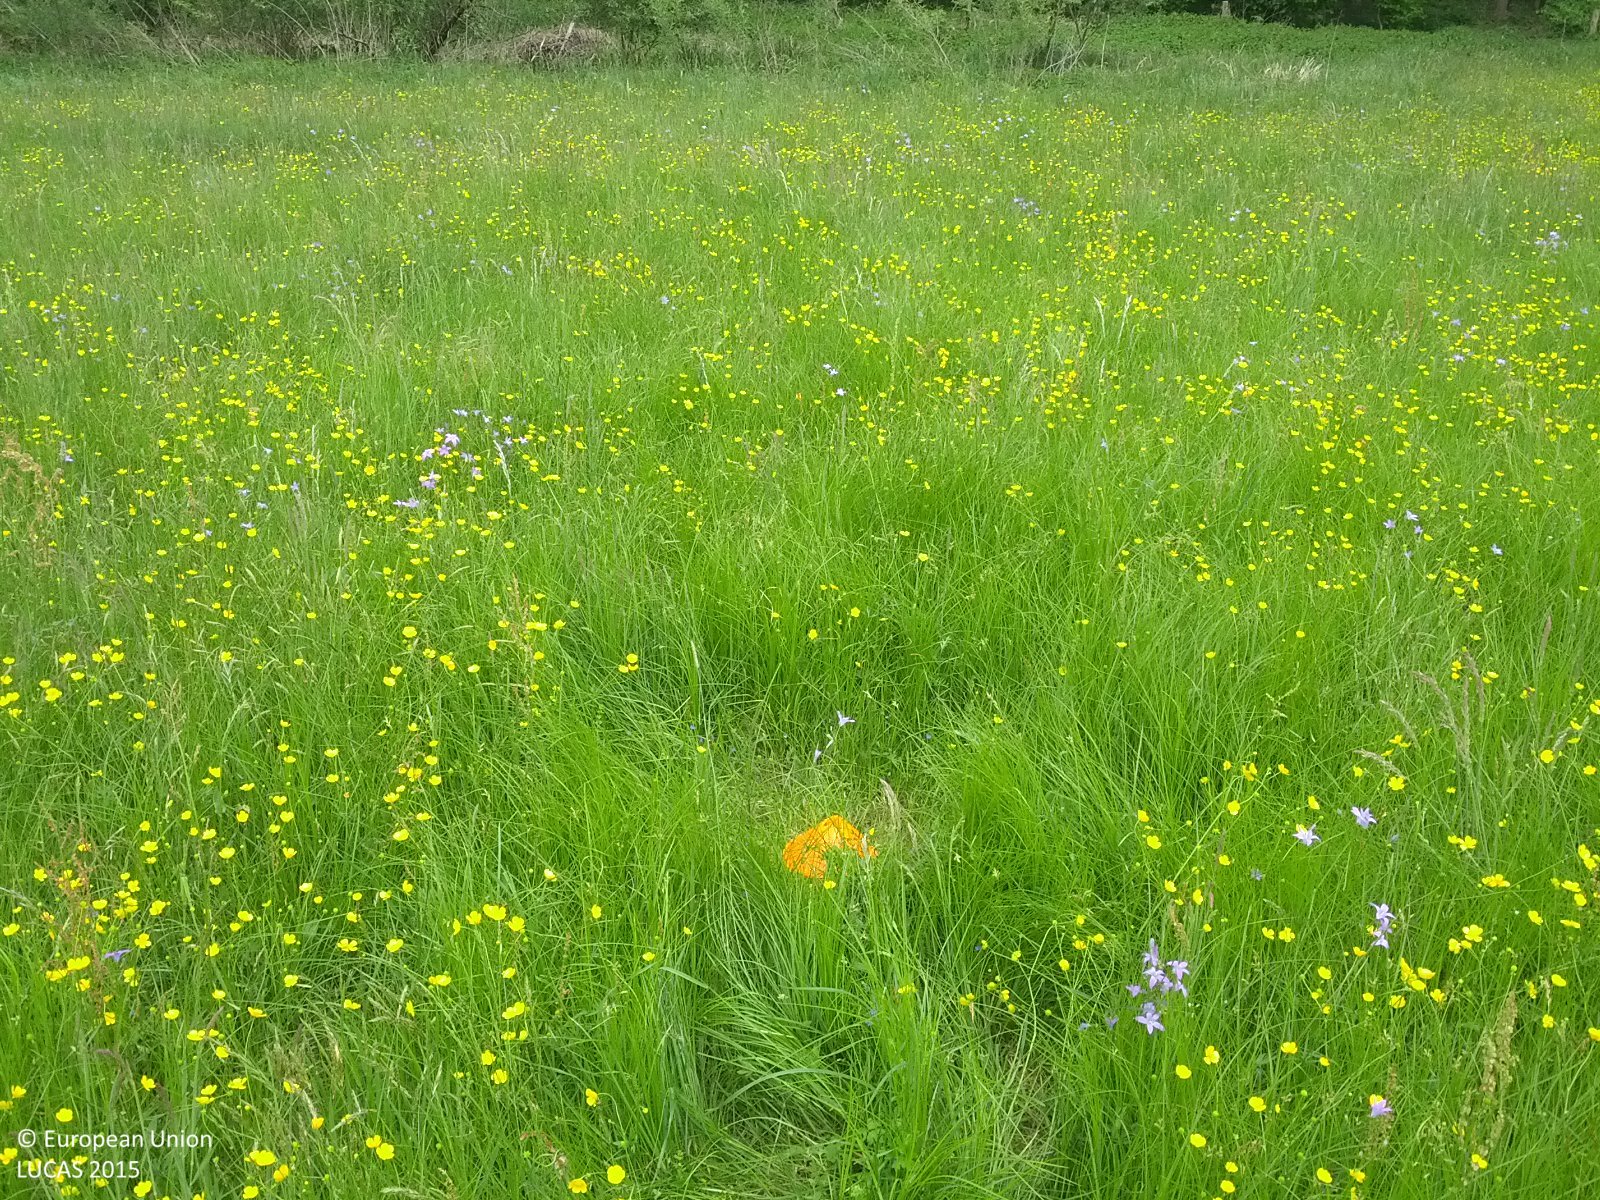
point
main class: Grassland
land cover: Grassland without tree/shrub cover
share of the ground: > 75 %
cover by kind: herbaceous plants 100 %
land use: Agriculture (excluding fallow land and kitchen gardens)
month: May
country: AT
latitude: 47.3355
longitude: 16.0499
